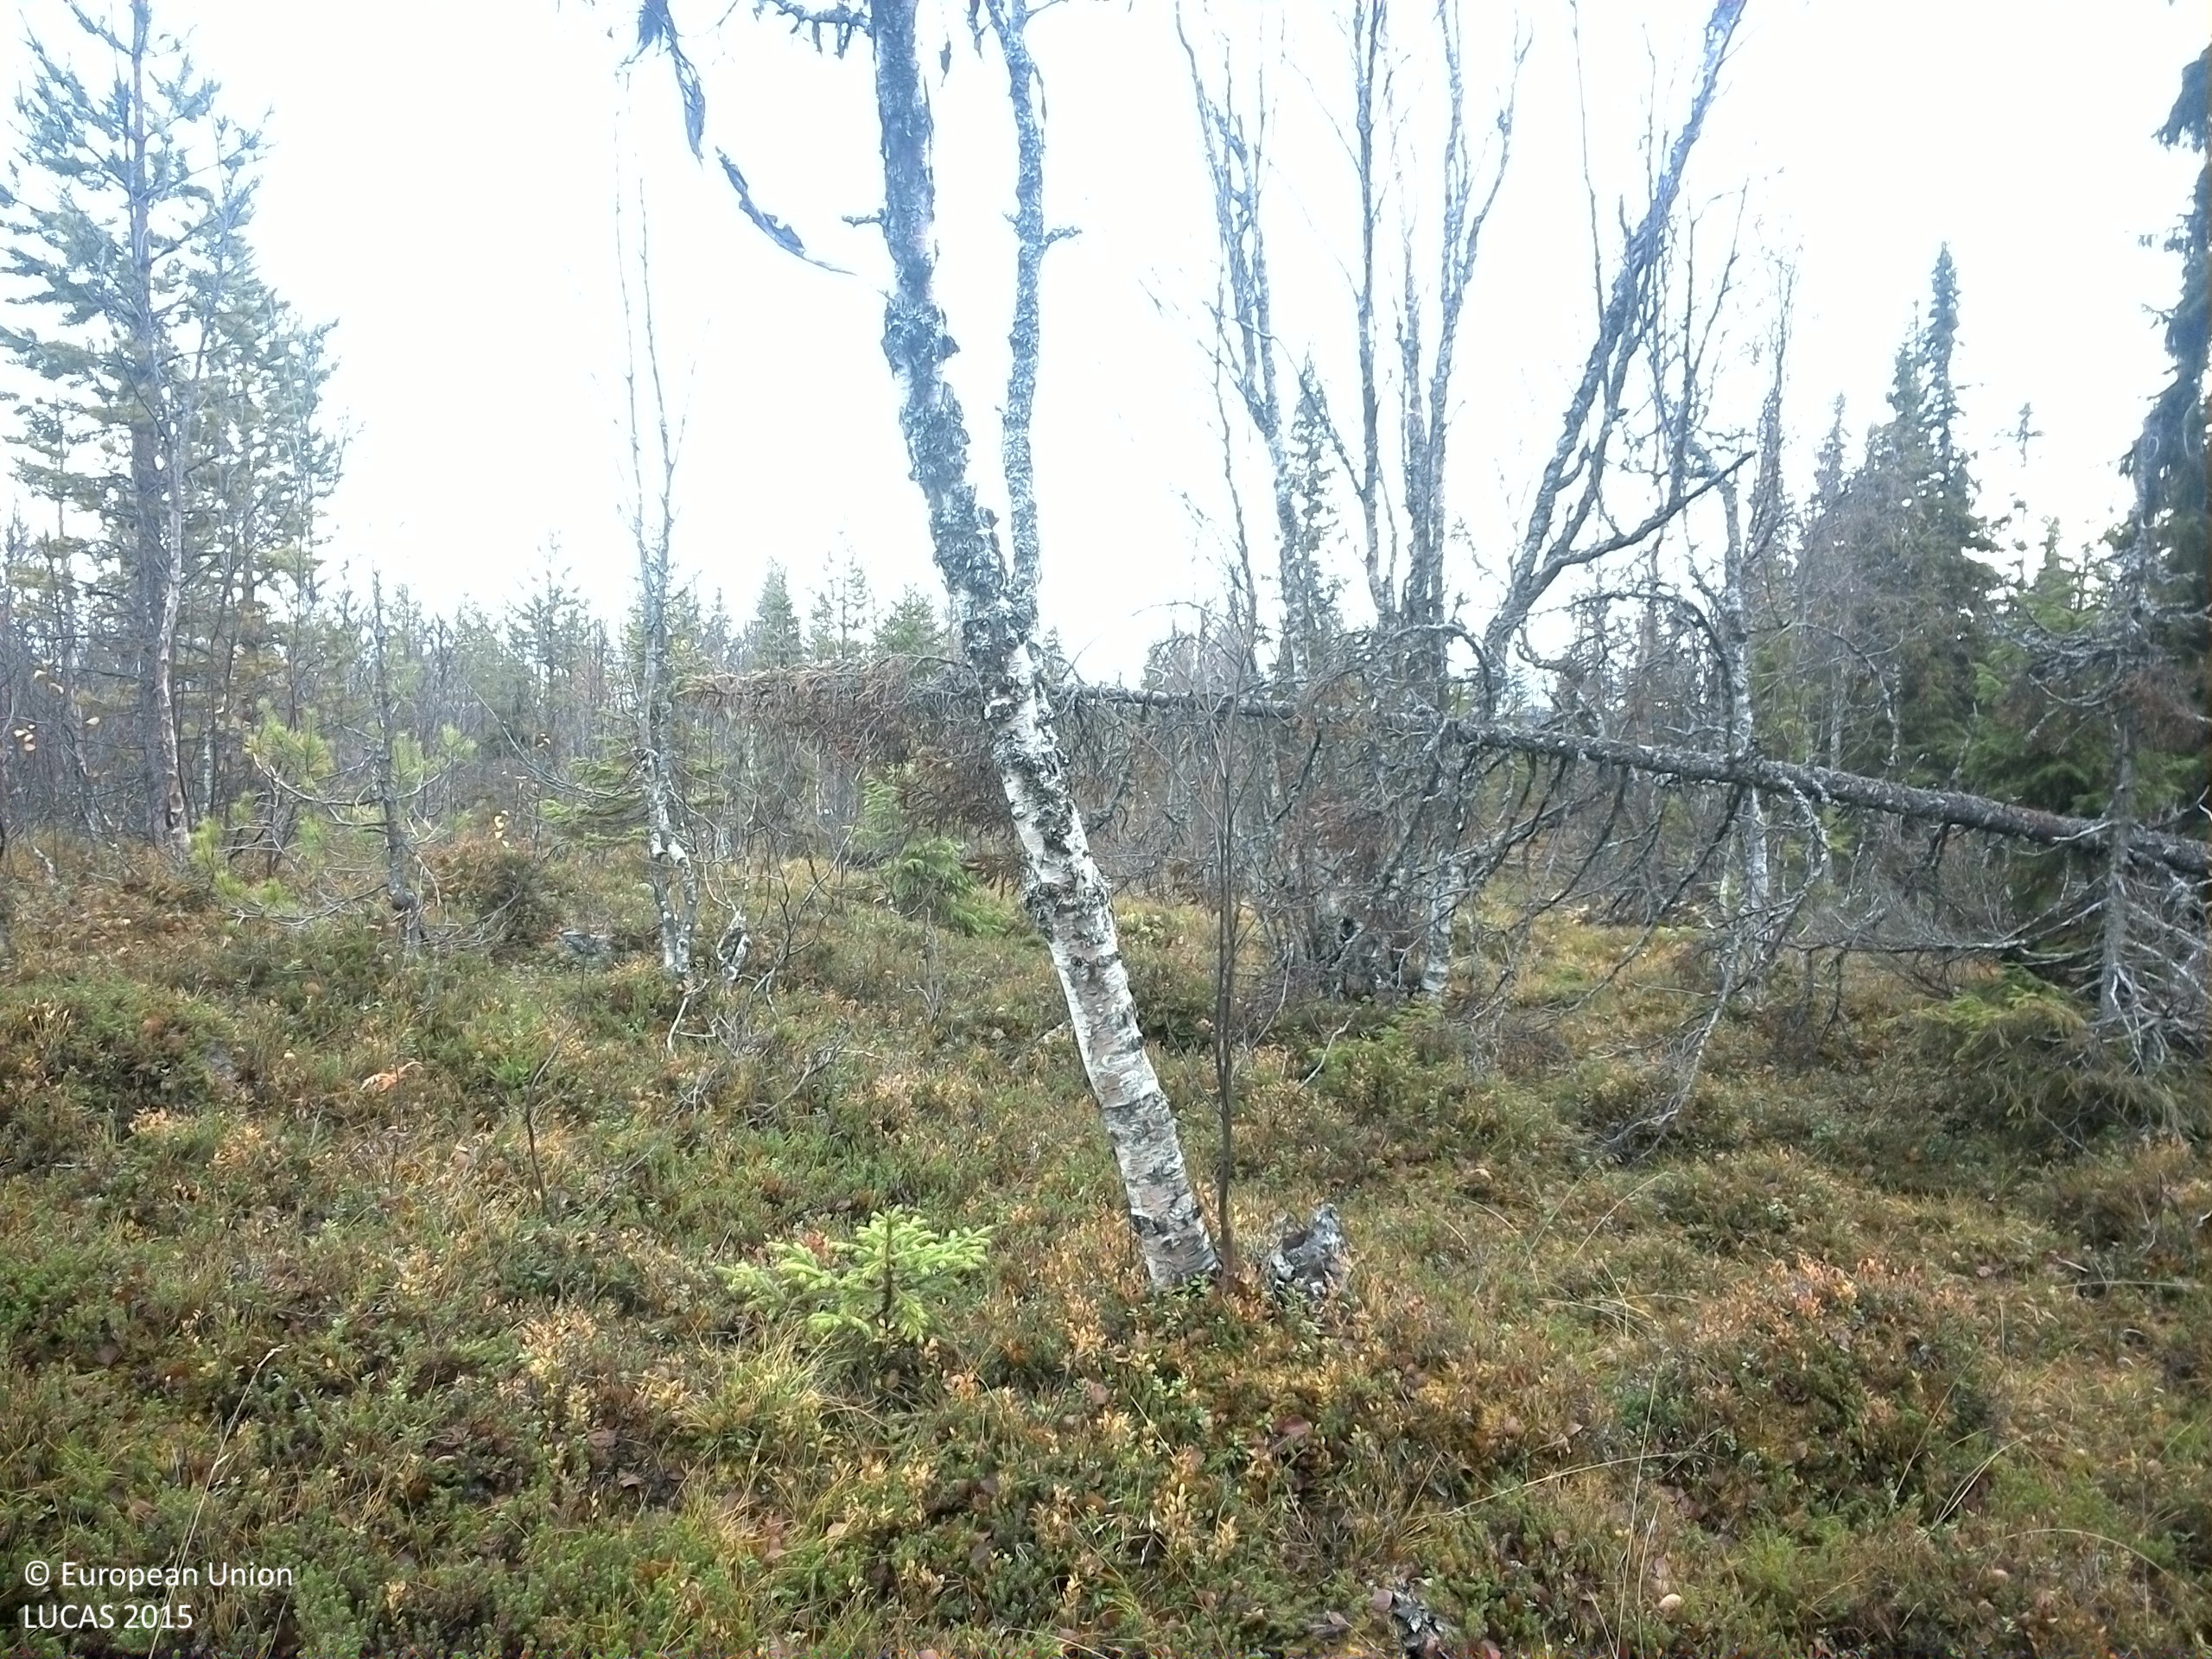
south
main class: Woodland
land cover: Pine dominated mixed woodland
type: boreal forest
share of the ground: 25 - 50 %
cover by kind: broadleaved forest trees 30 %, shrubs 30 %, coniferous forest trees 15 %, lichens and mosses 15 %, consolidated bare surface 10 %
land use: Forestry
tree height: < 5 m
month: October
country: SE
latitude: 64.4337
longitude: 14.8117
